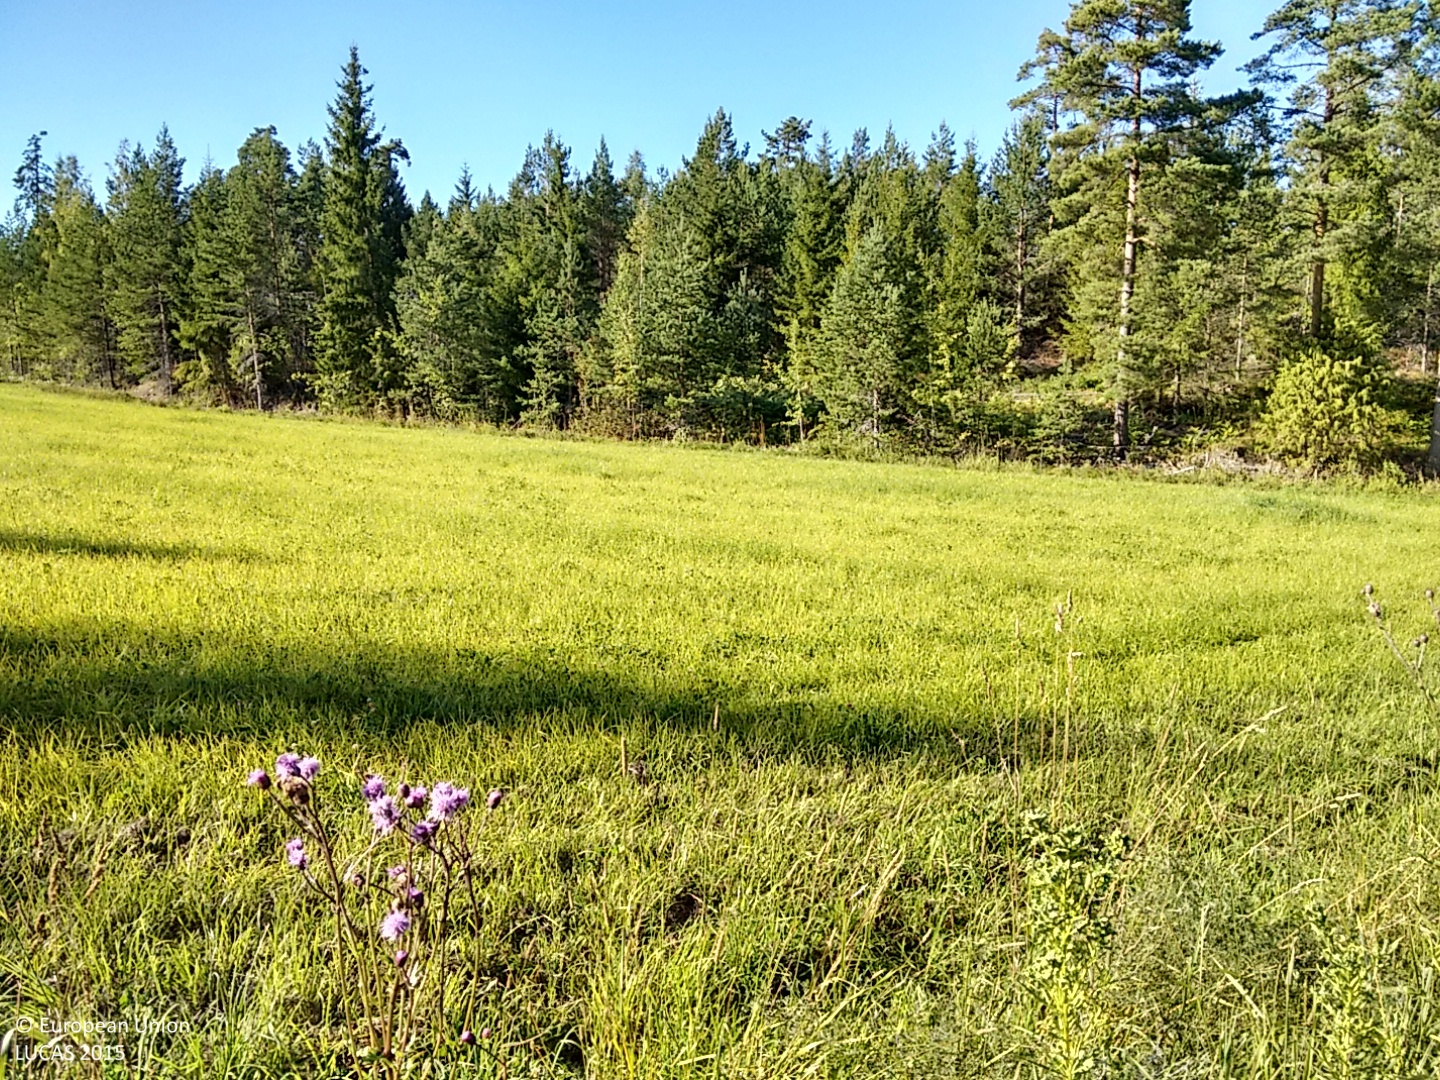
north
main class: Grassland
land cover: Spontaneously vegetated surfaces
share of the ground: > 75 %
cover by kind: herbaceous plants 100 %
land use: Semi-natural and natural areas not in use
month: August
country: FI
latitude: 60.3546
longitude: 19.9558
